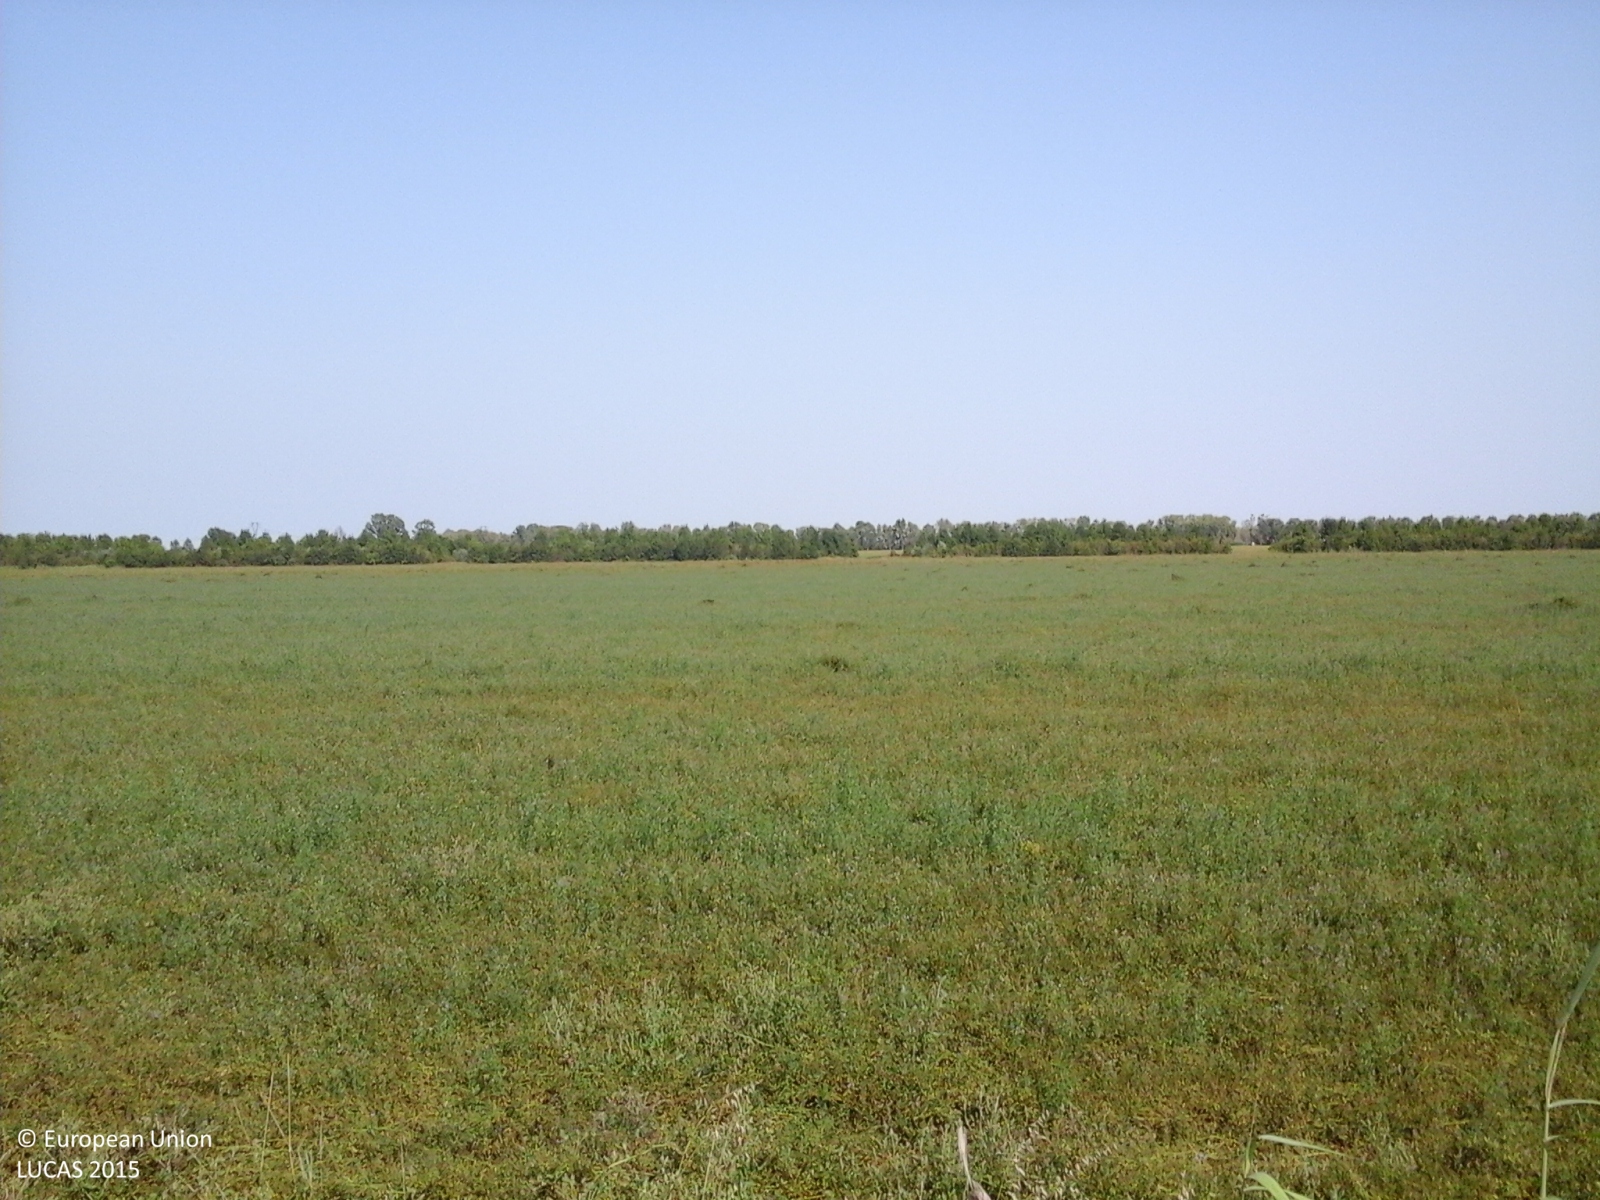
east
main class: Cropland
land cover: Lucerne
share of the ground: > 75 %
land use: Agriculture (excluding fallow land and kitchen gardens)
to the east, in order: Lucerne
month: July
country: IT
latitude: 44.5351
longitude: 11.6953
